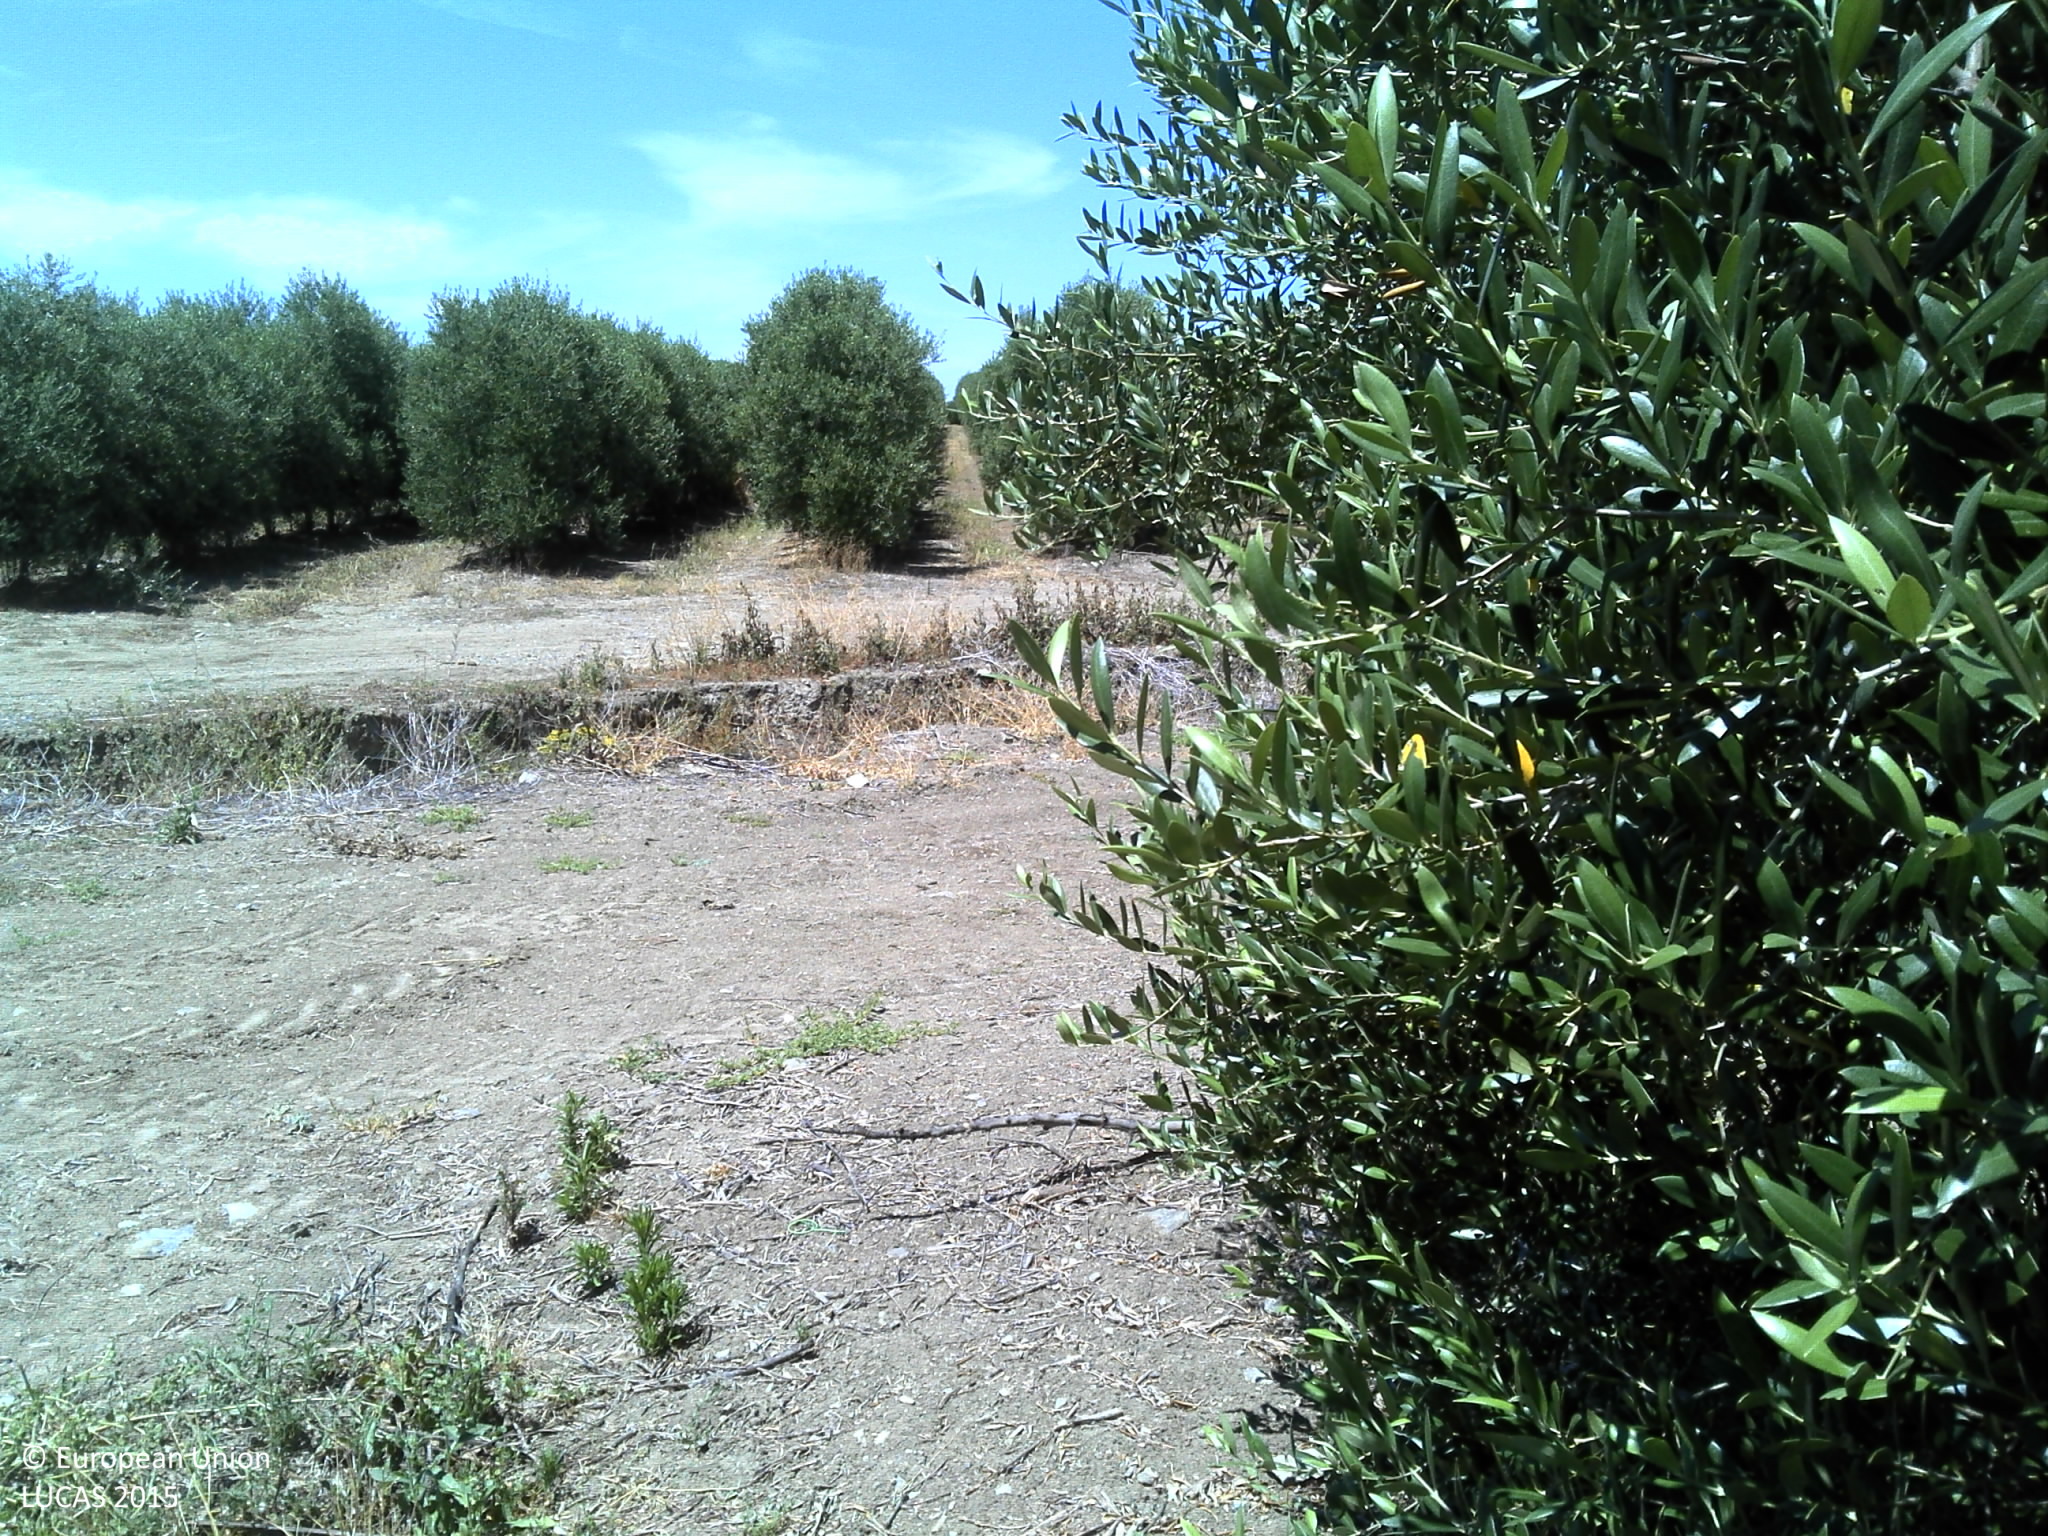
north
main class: Cropland
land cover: Olive groves
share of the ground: 50 - 75 %
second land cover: Grassland without tree/shrub cover
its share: 25 - 50 %
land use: Agriculture (excluding fallow land and kitchen gardens)
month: June
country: PT
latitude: 37.9538
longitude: -7.5341
